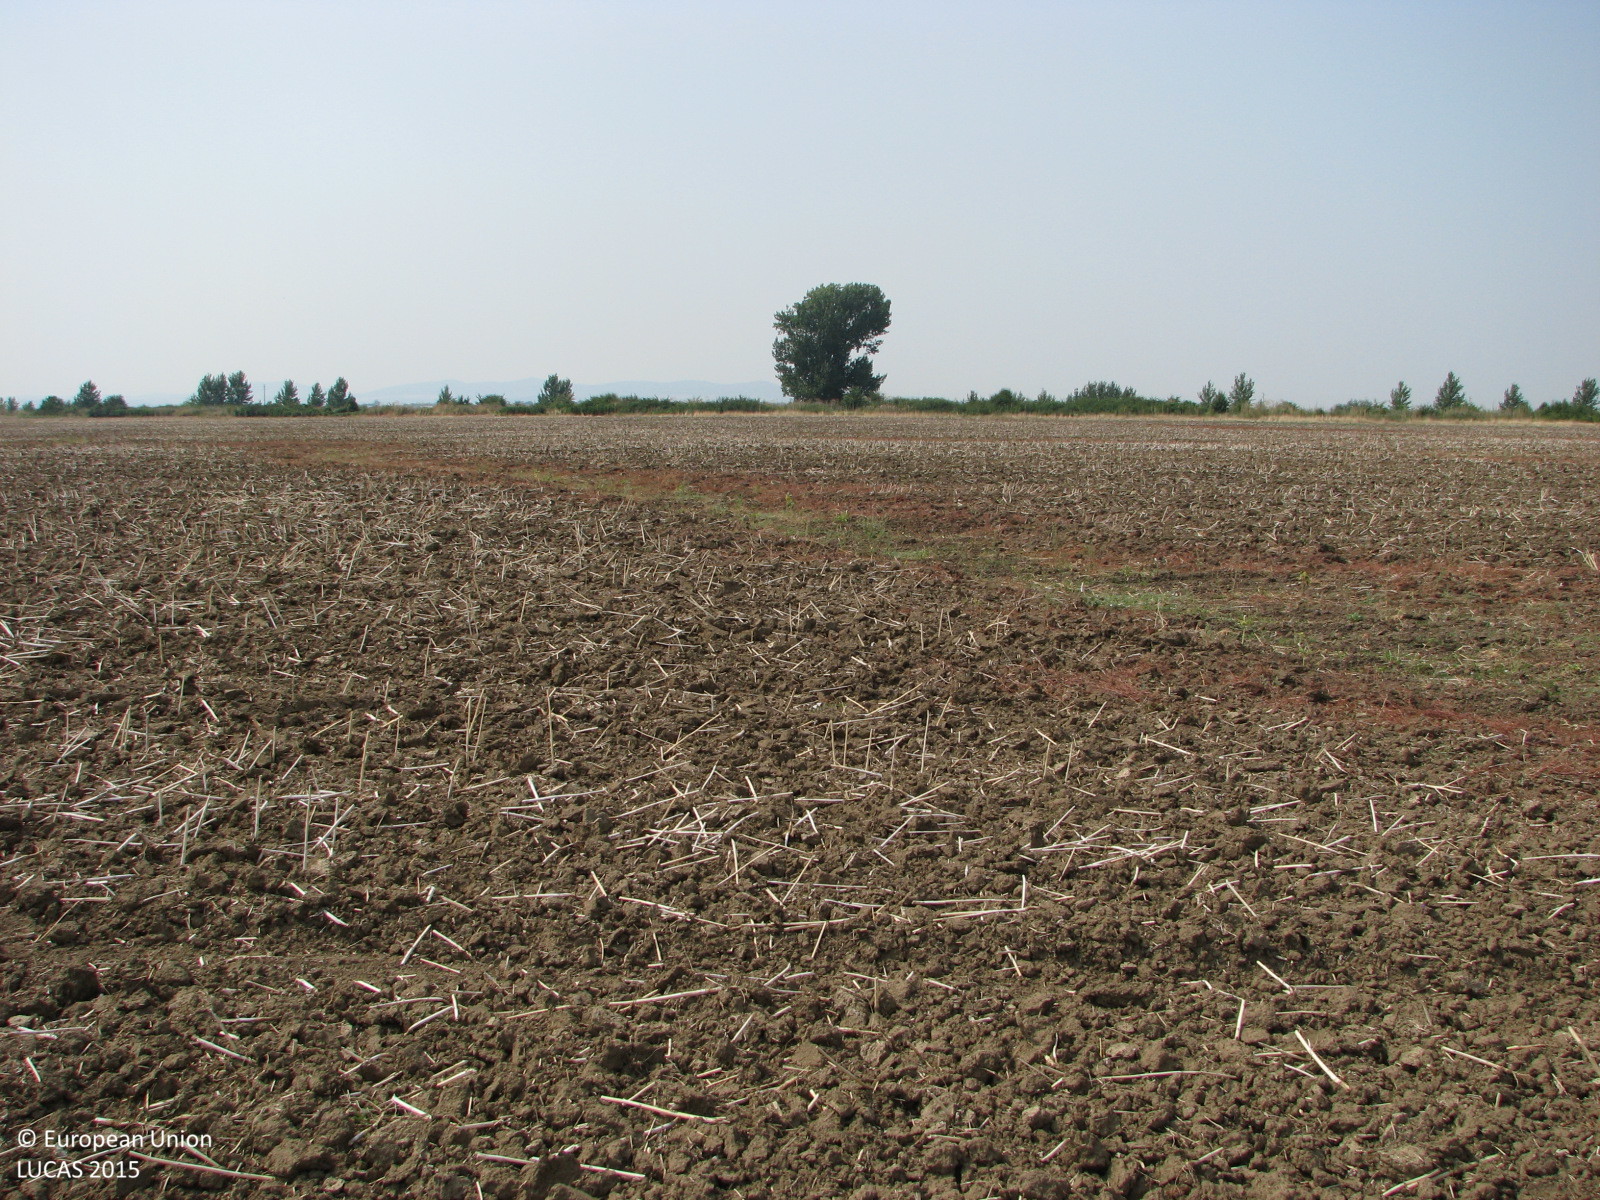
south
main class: Cropland
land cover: Sunflower
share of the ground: < 10 %
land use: Agriculture (excluding fallow land and kitchen gardens)
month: July
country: BG
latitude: 42.6367
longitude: 26.6964
